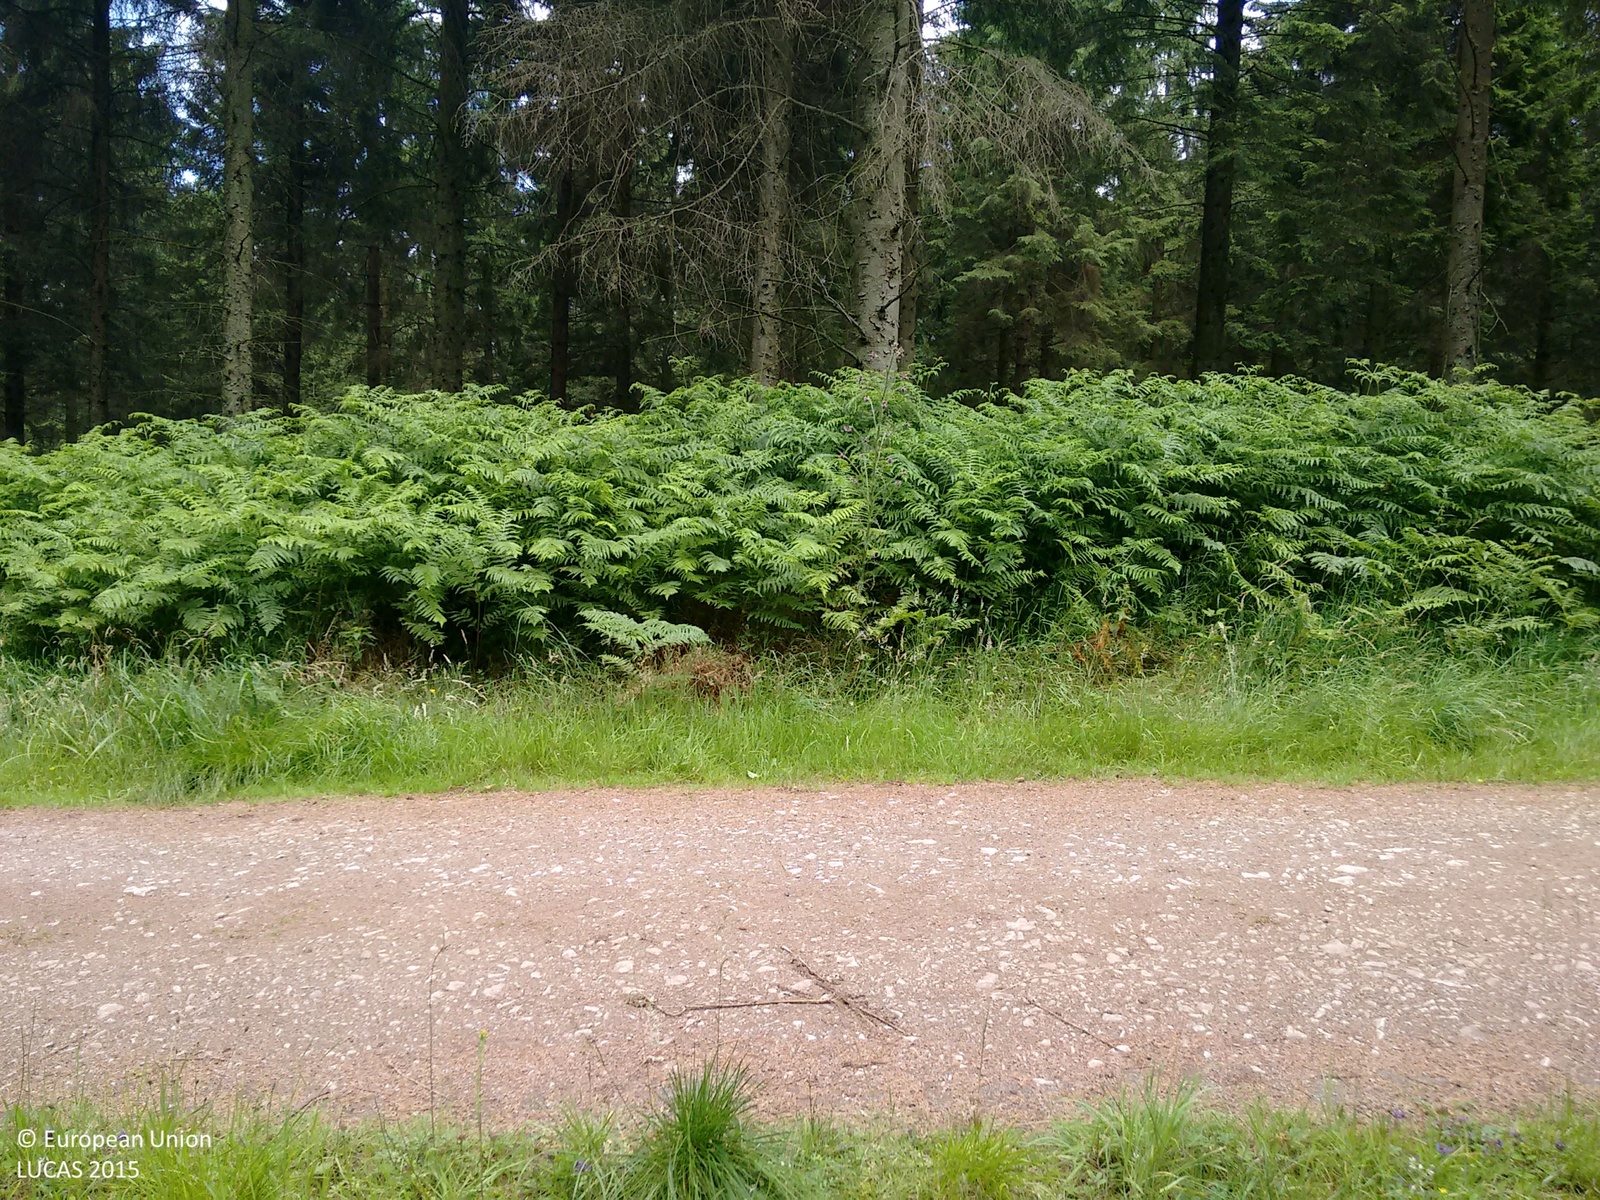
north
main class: Woodland
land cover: Spruce dominated coniferous woodland
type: exotic forest
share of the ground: > 75 %
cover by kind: coniferous forest trees 100 %
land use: Forestry
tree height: > 5 m
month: July
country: GB
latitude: 51.3200
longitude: -2.7698
